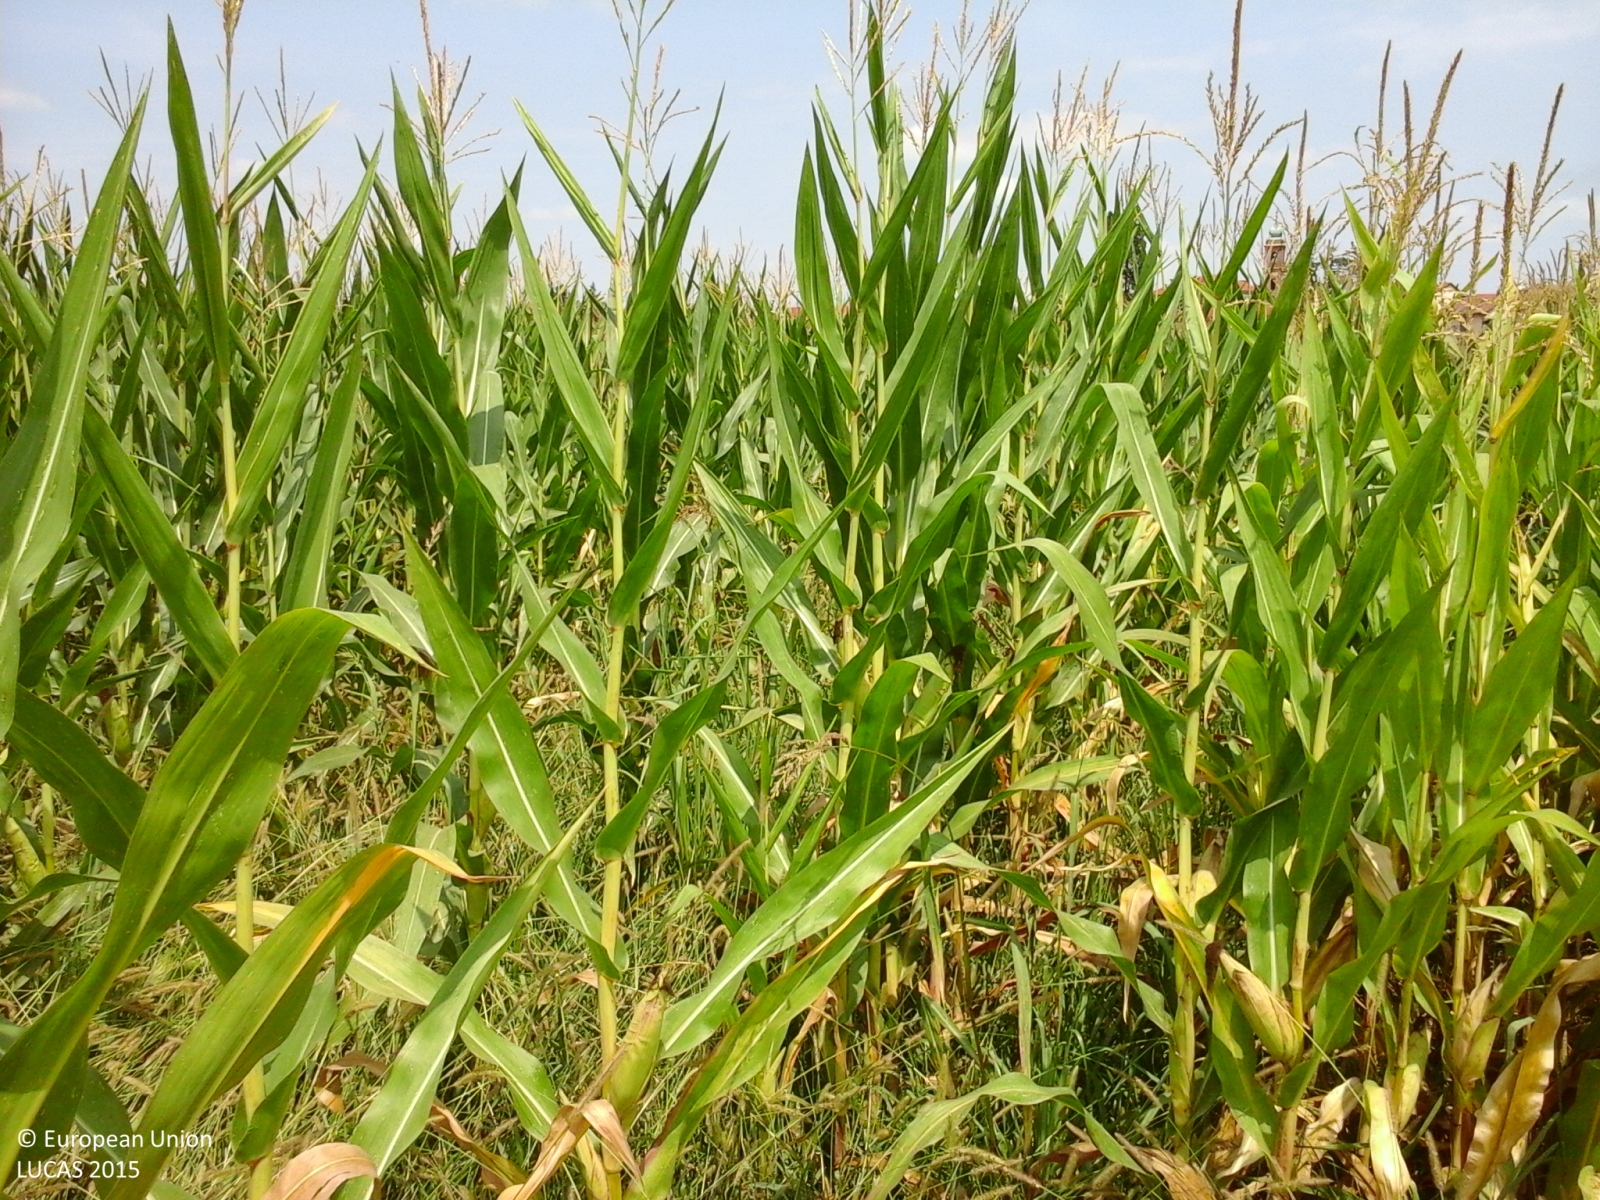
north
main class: Cropland
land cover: Maize
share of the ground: > 75 %
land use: Agriculture (excluding fallow land and kitchen gardens)
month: July
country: IT
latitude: 44.7966
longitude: 7.8173
